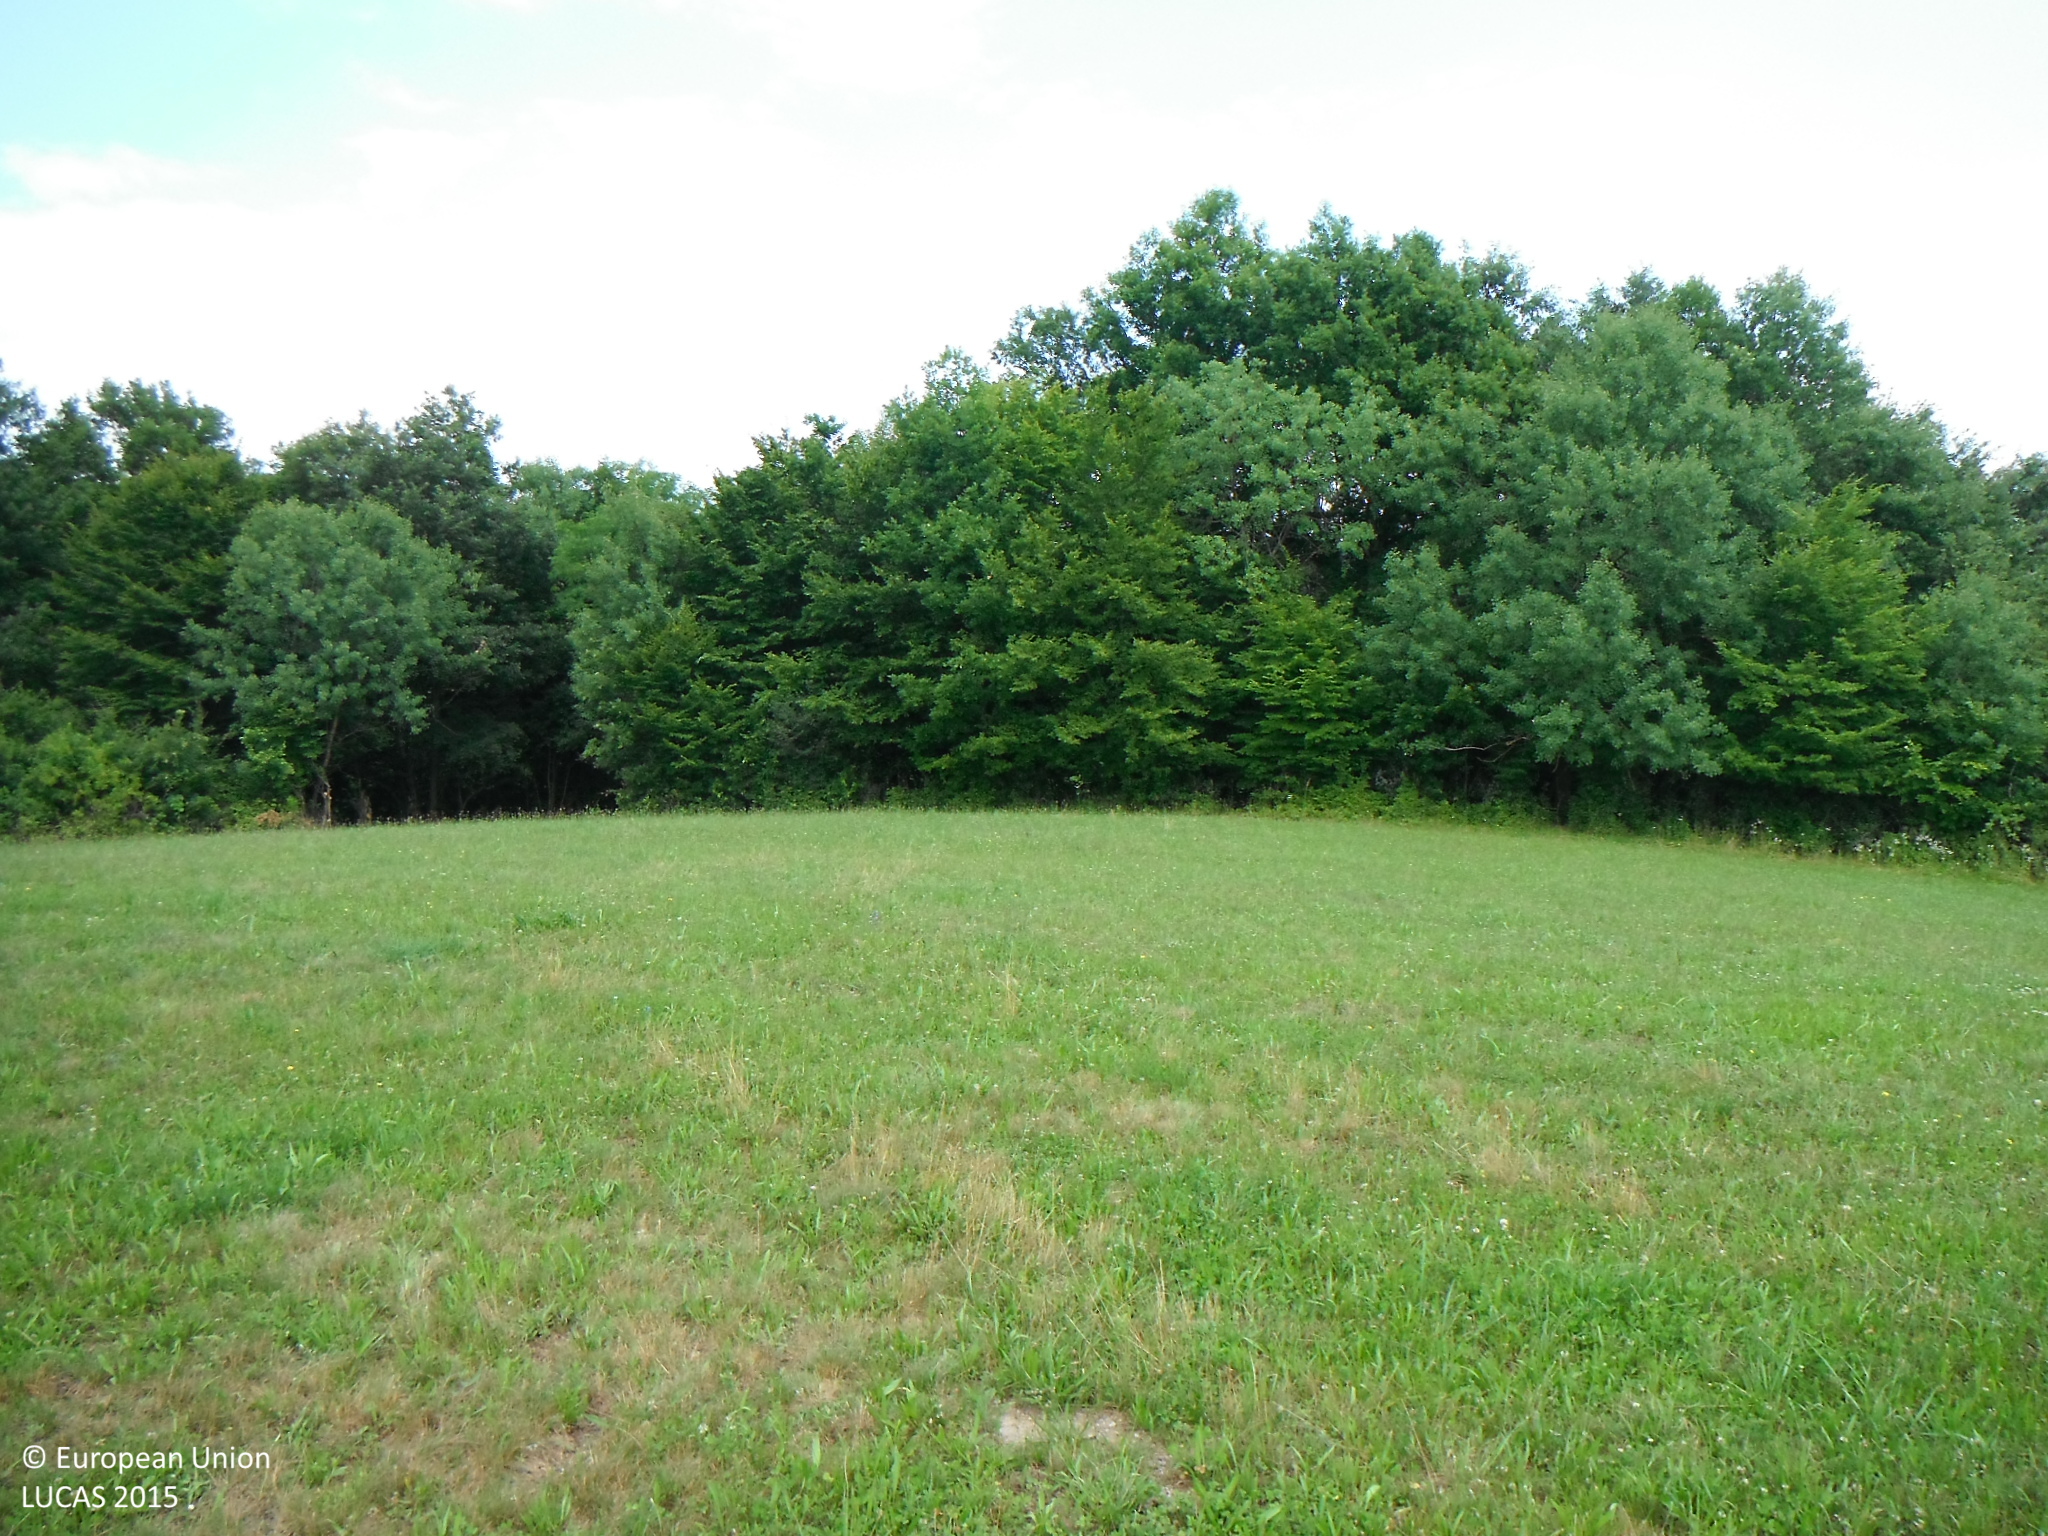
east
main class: Grassland
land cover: Grassland without tree/shrub cover
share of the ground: > 75 %
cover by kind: herbaceous plants 100 %
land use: Agriculture (excluding fallow land and kitchen gardens)
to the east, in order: Grassland without tree/shrub cover; Broadleaved woodland; Grassland without tree/shrub cover; Broadleaved woodland
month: June
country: SK
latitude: 48.5259
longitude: 20.0365
